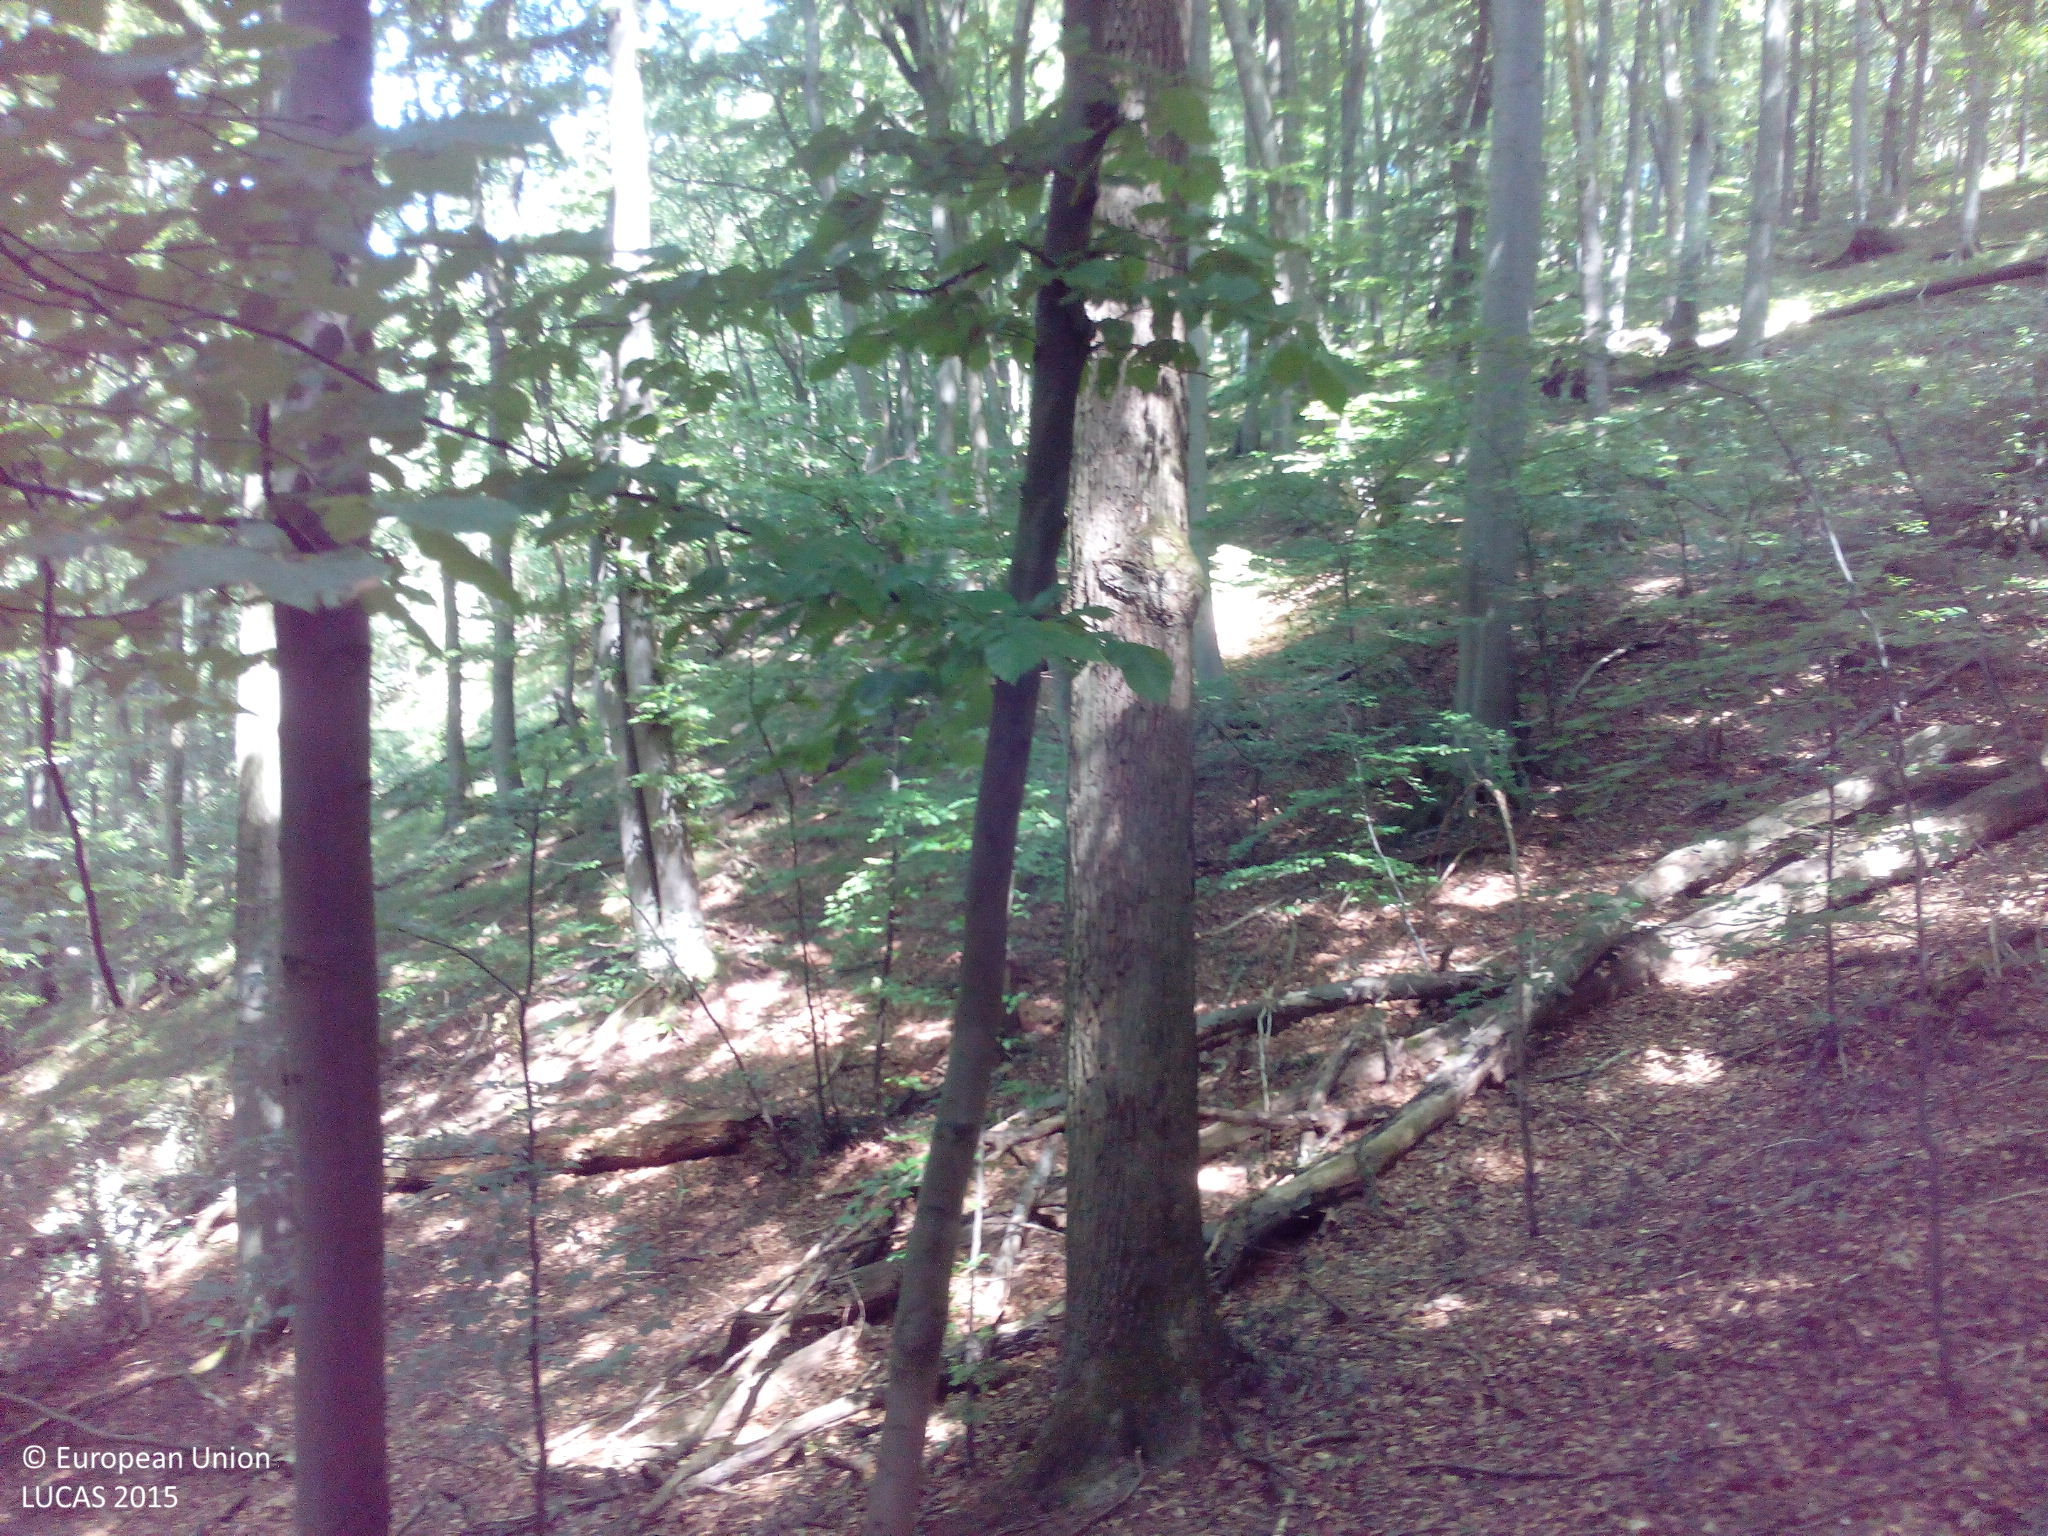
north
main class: Woodland
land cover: Broadleaved woodland
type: beech forest
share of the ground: > 75 %
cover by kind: broadleaved forest trees 100 %
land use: Forestry
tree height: > 5 m
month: August
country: DE
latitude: 51.6387
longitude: 9.3500
